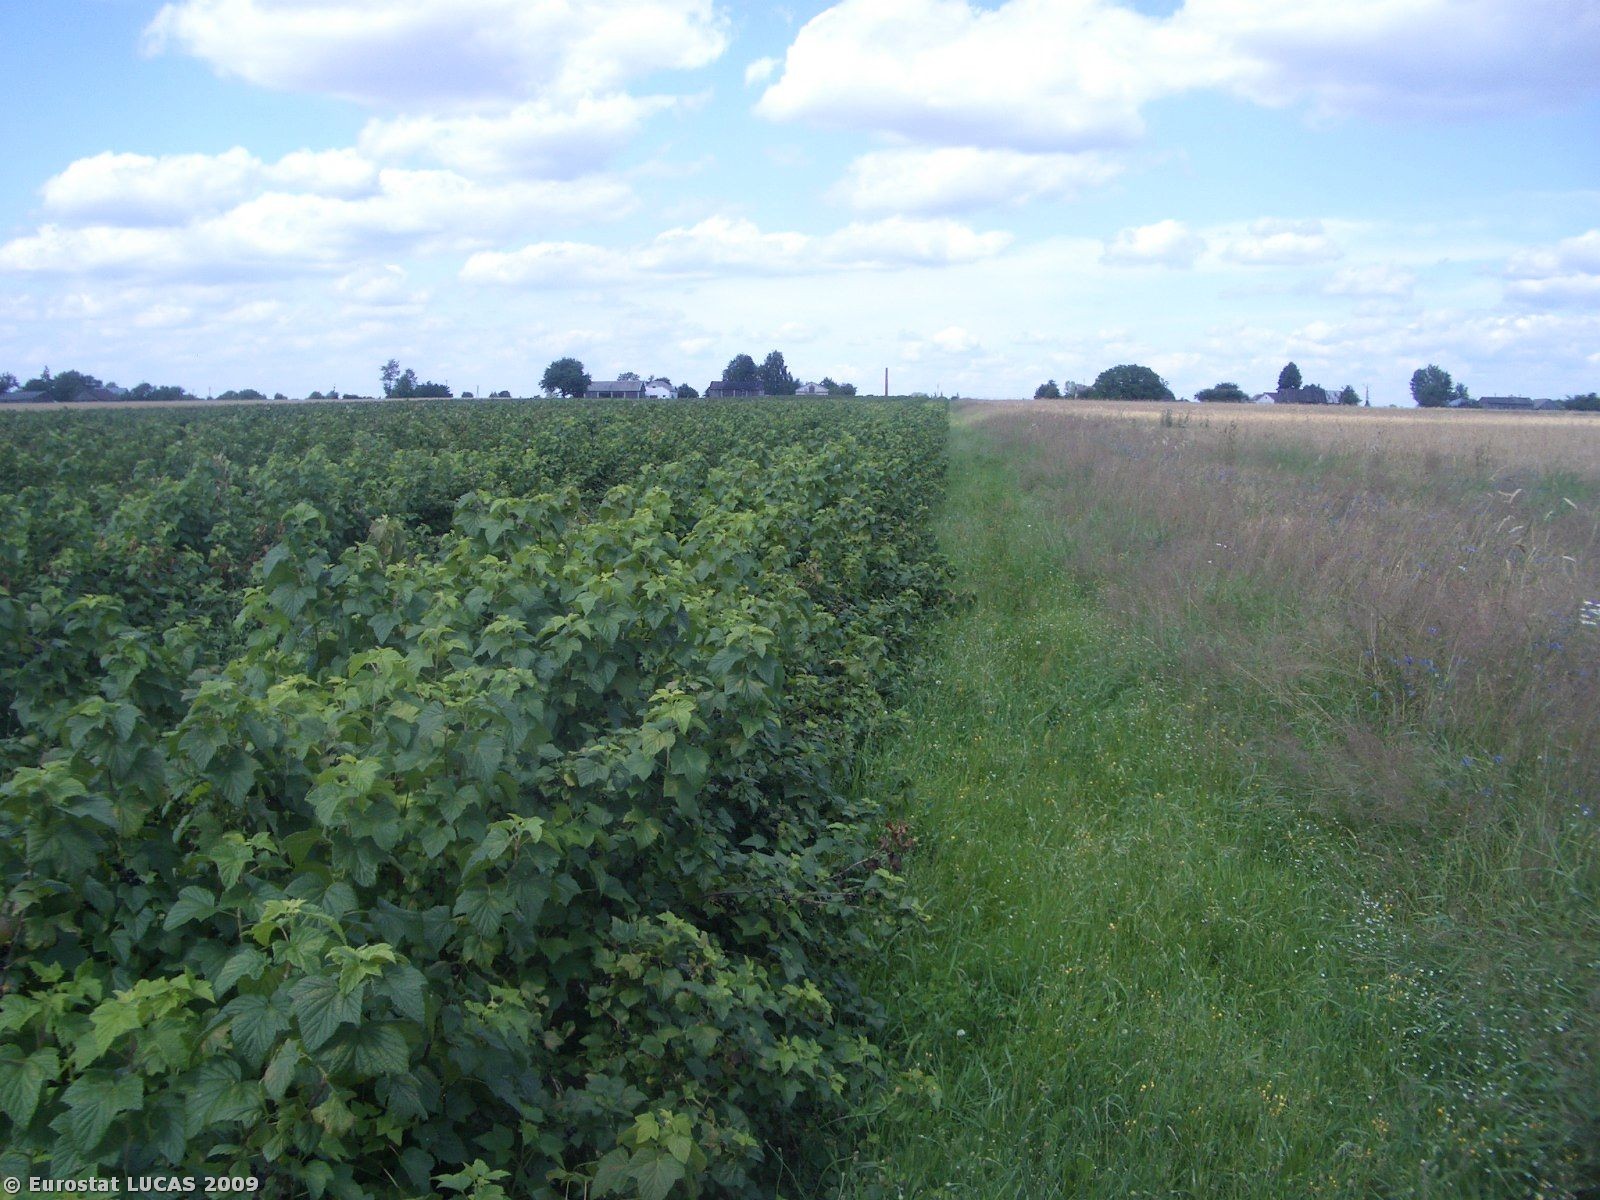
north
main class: Cropland
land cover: Other fruit trees and berries
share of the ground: 25 - 50 %
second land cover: Grassland with sparse tree/shrub cover
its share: 25 - 50 %
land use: Agriculture (excluding fallow land and kitchen gardens)
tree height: < 5 m
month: July
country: PL
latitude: 52.1817
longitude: 23.0485
